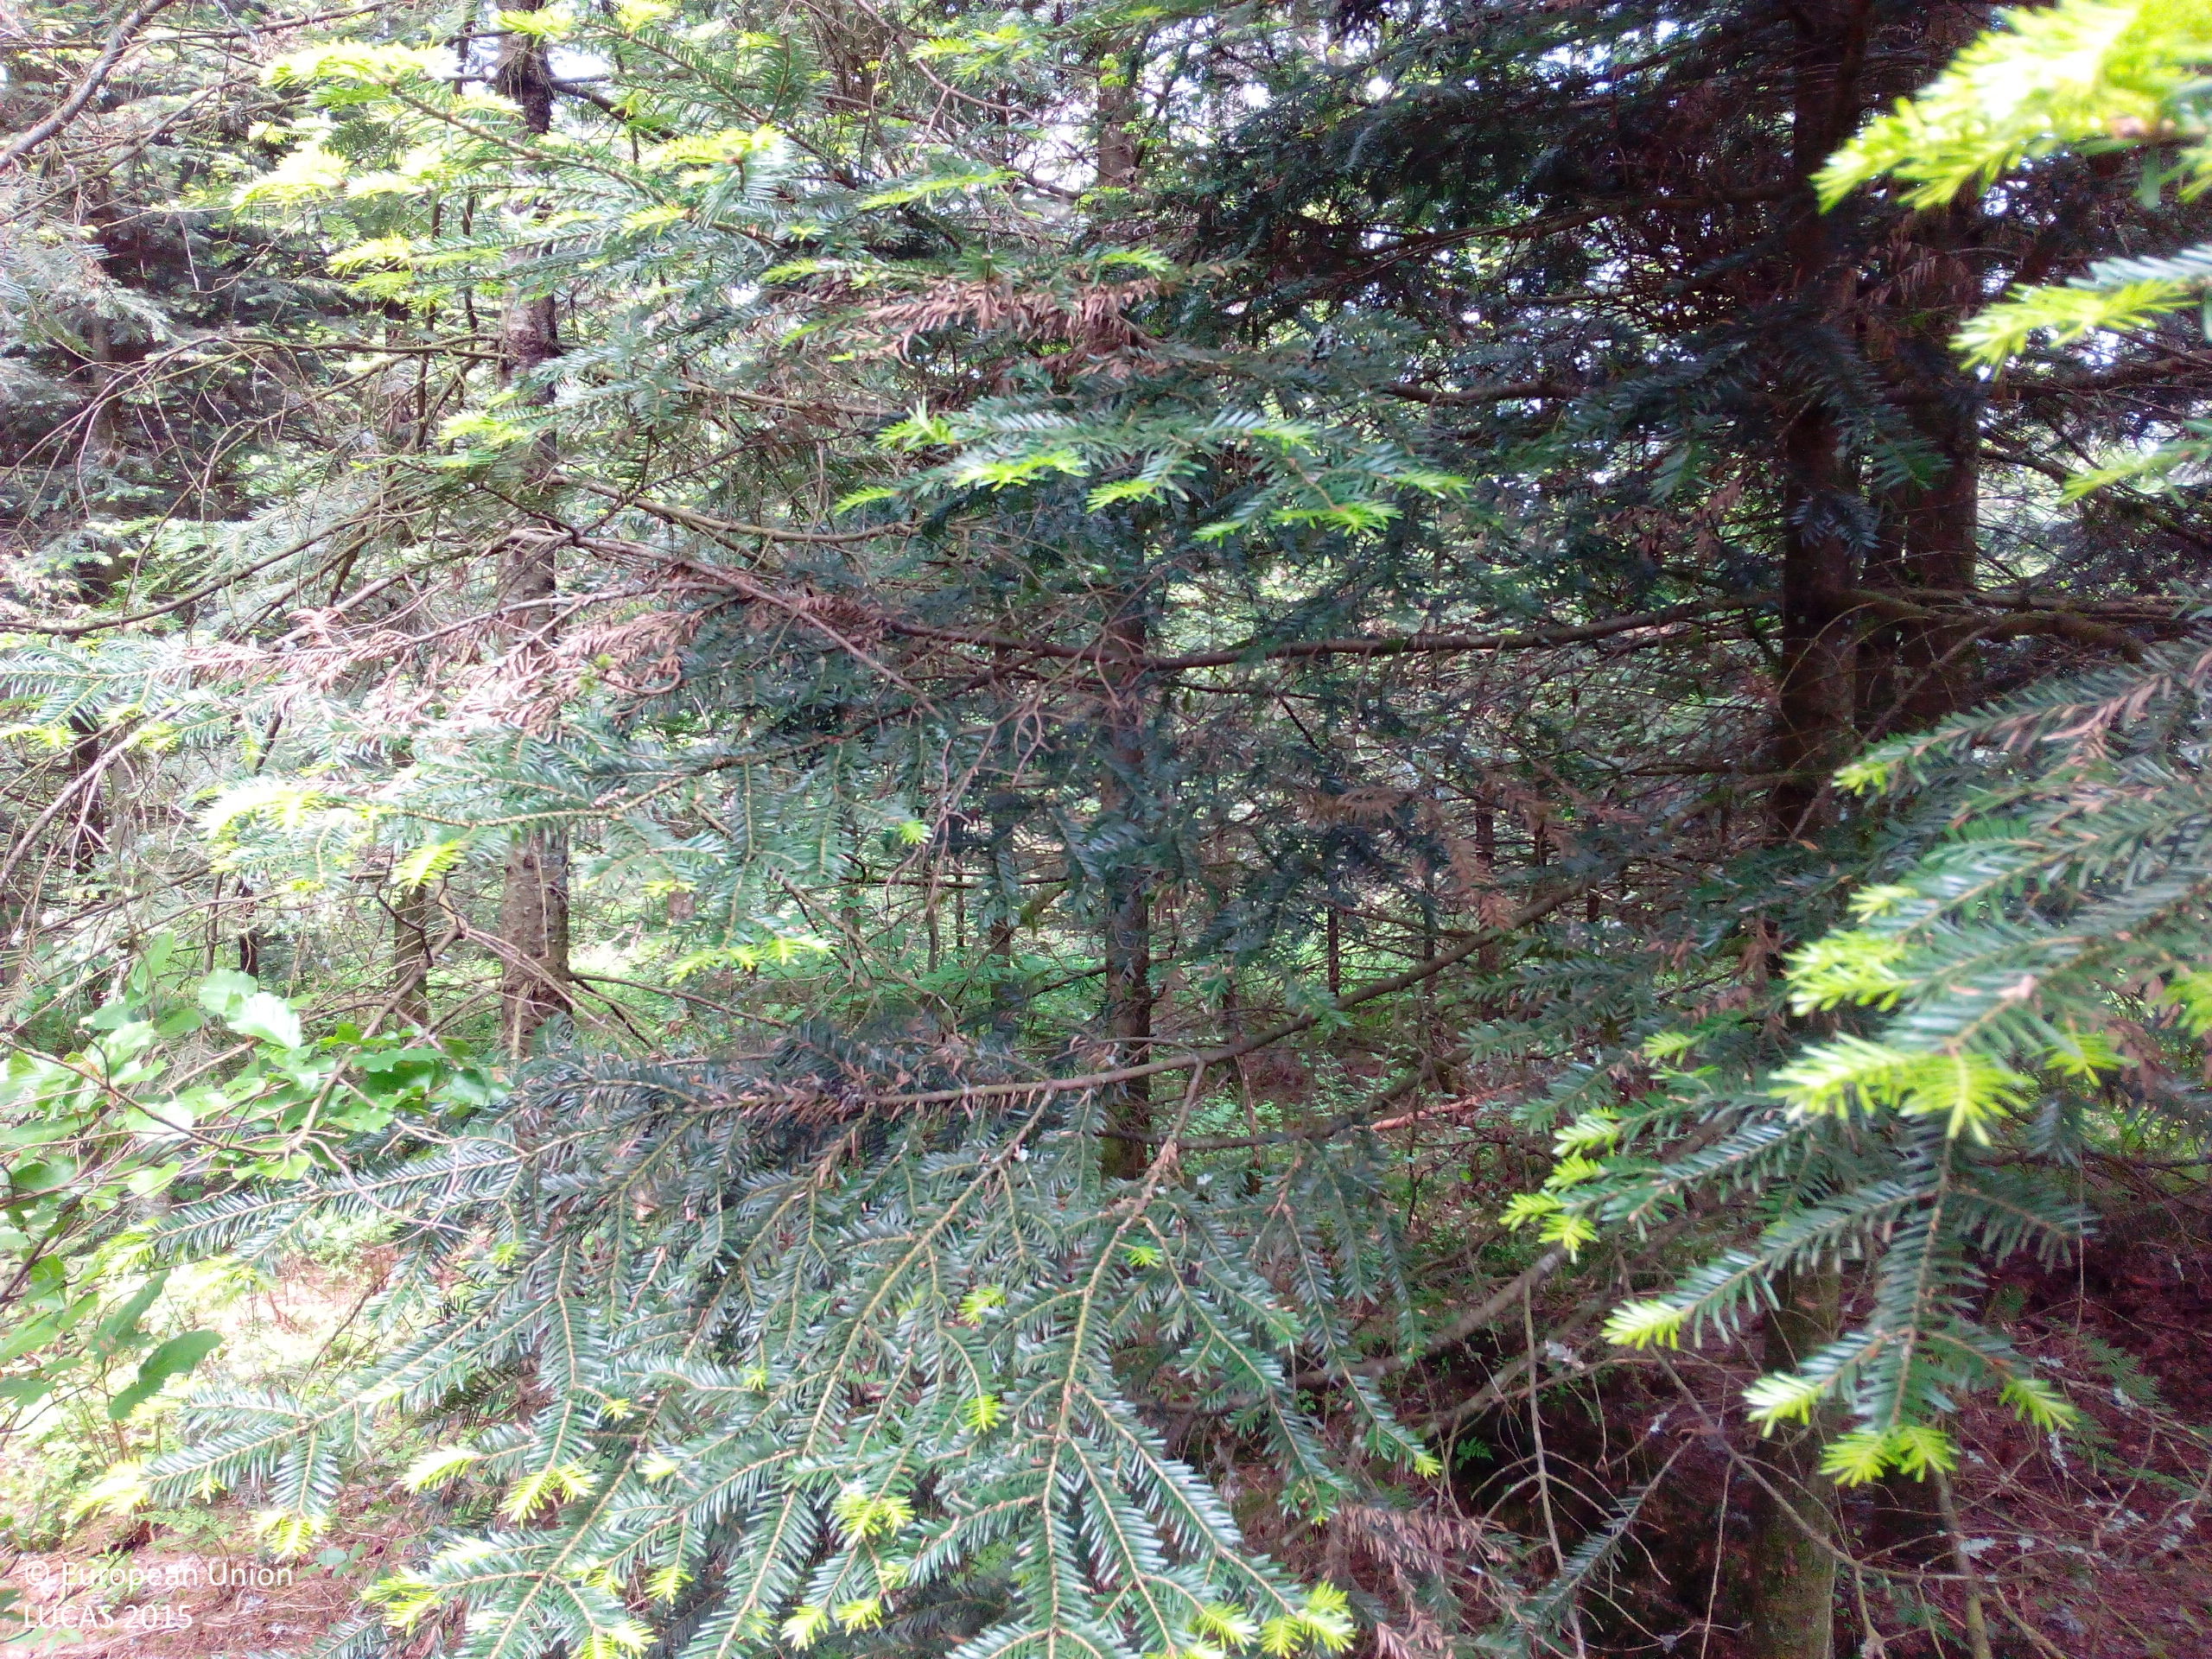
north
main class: Woodland
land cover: Other mixed woodland
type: hemiboreal forest and nemoral coniferous forest and mixed broadleaved-coniferous forest
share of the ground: > 75 %
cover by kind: coniferous forest trees 70 %, broadleaved forest trees 30 %
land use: Forestry
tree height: > 5 m
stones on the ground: < 10 %
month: May
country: DE
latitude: 47.9918
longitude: 8.1384
